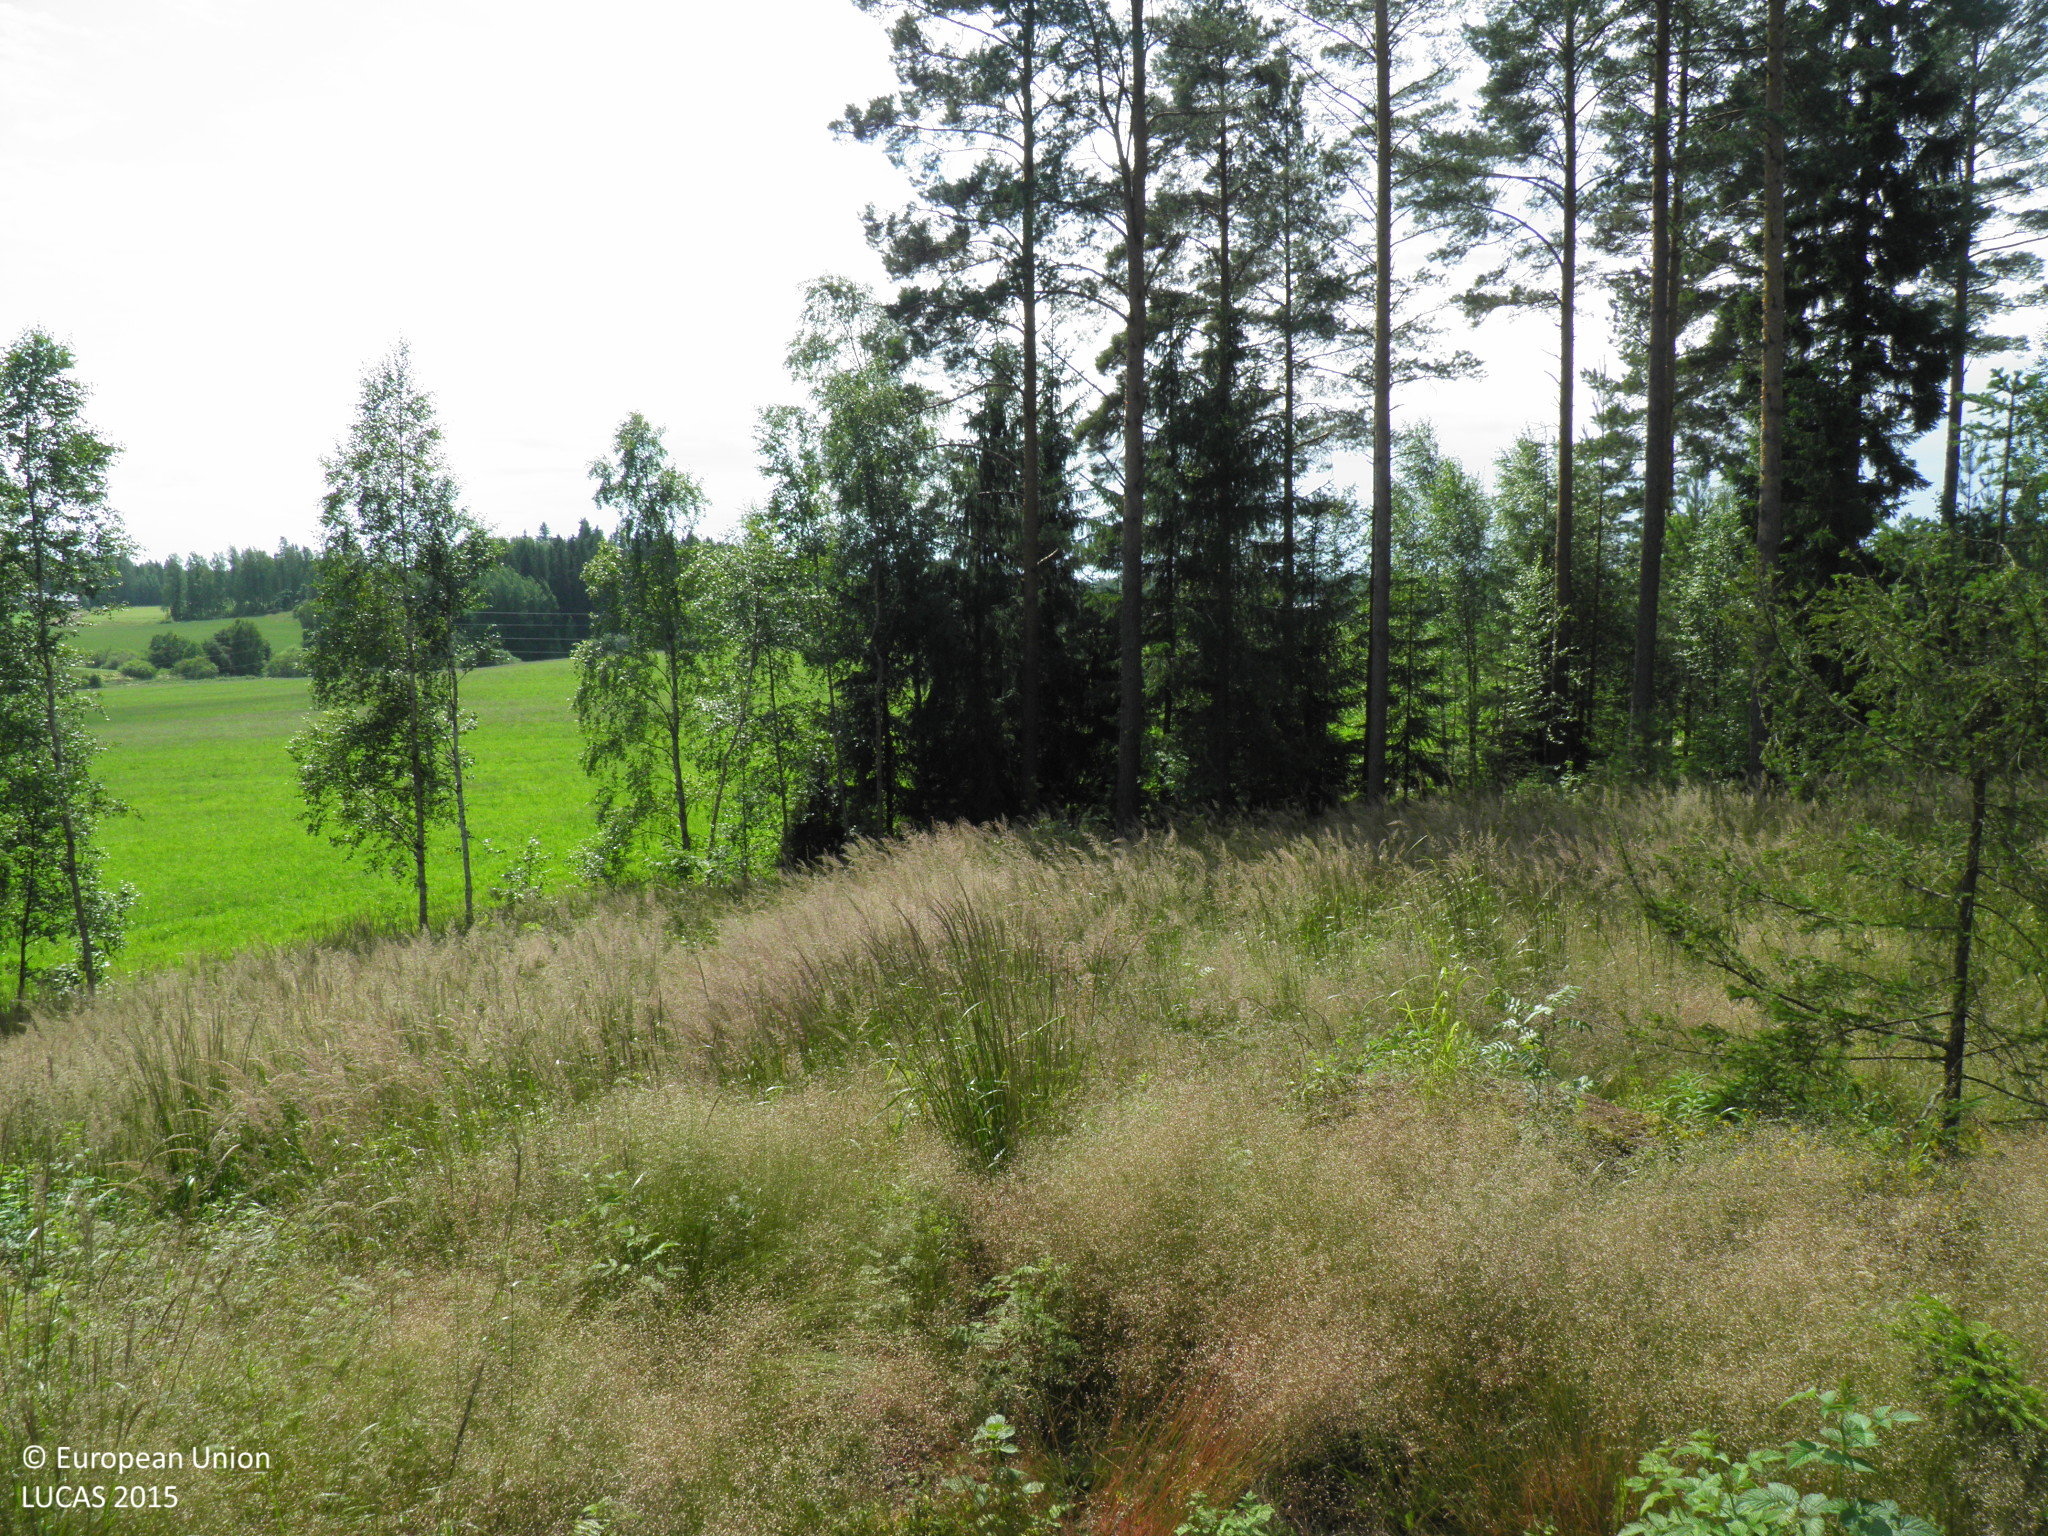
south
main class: Woodland
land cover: Pine dominated coniferous woodland
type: hemiboreal forest and nemoral coniferous forest and mixed broadleaved-coniferous forest
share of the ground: 10 - 25 %
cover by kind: herbaceous plants 65 %, coniferous forest trees 20 %, broadleaved forest trees 5 %, shrubs 5 %, unconsolidated bare surface 5 %
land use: Forestry
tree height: > 5 m
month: July
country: FI
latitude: 60.8290
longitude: 22.4825
